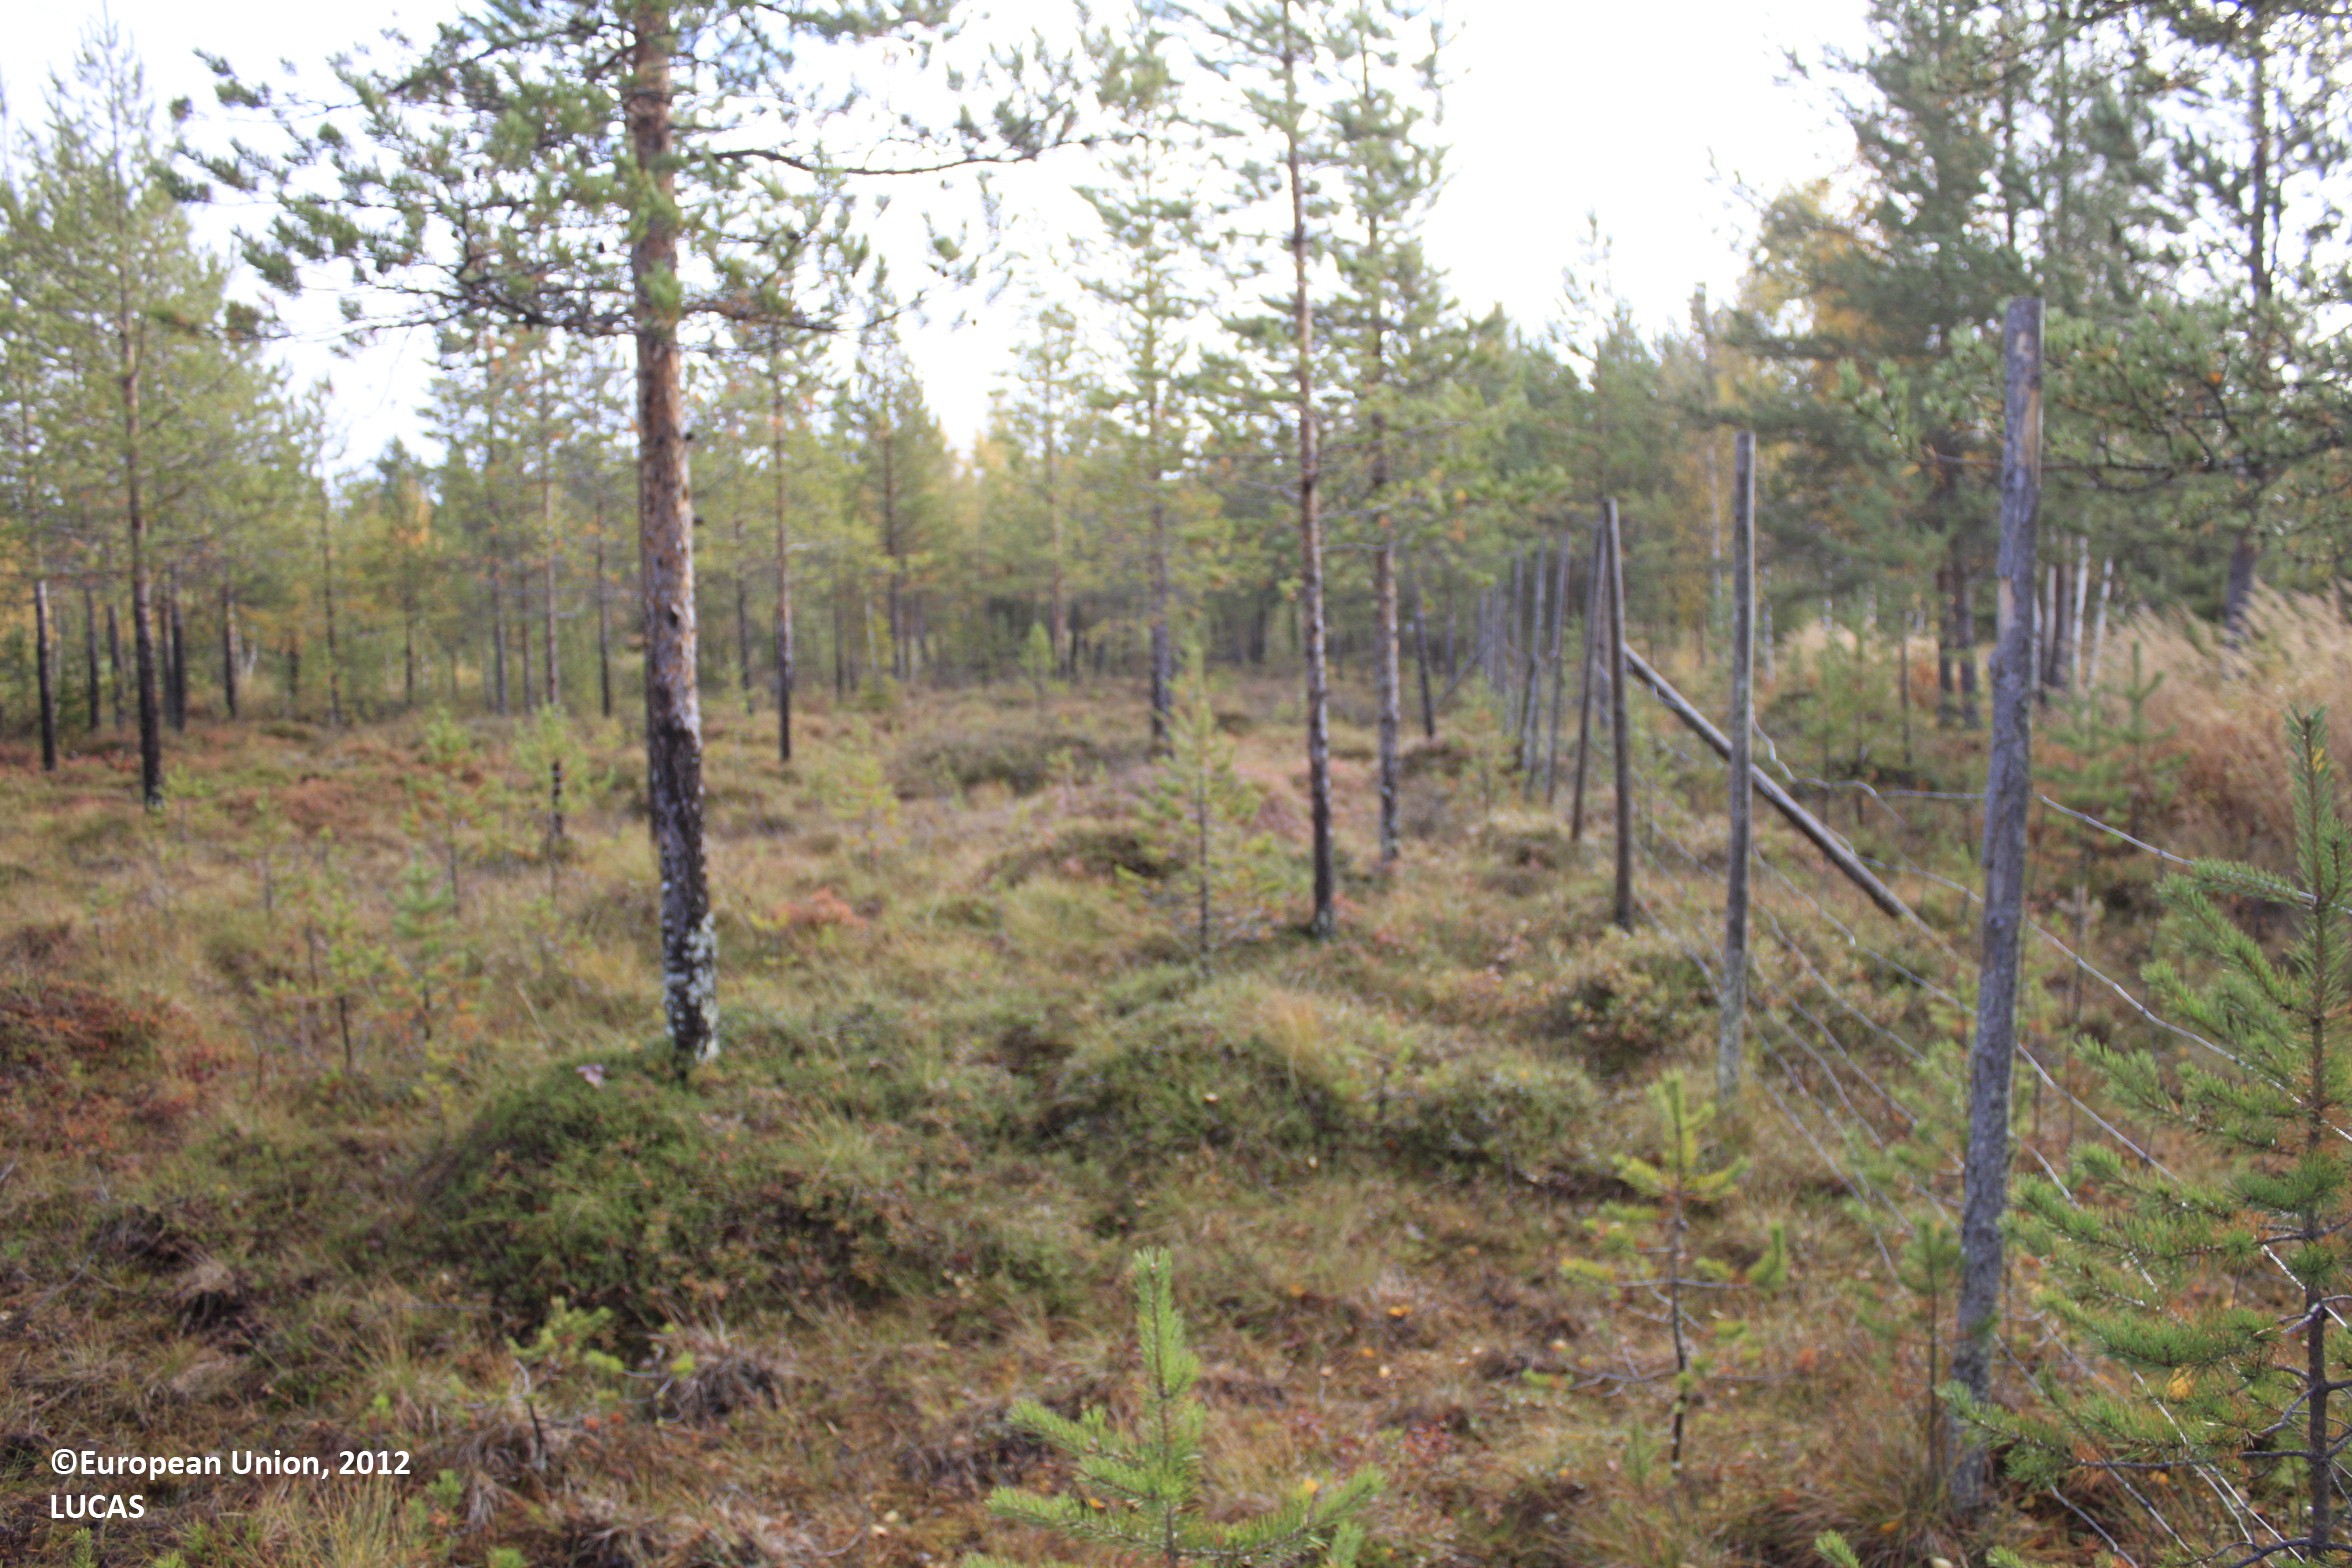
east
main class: Grassland
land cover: Grassland without tree/shrub cover
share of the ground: 25 - 50 %
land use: Agriculture (excluding fallow land and kitchen gardens)
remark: Tilled/Sowed
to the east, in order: Grassland without tree/shrub cover; Broadleaved woodland; Rivers and streams; Pine dominated mixed woodland; Ditches and canals; Pine dominated mixed woodland
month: September
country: FI
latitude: 66.0336
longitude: 26.8483
